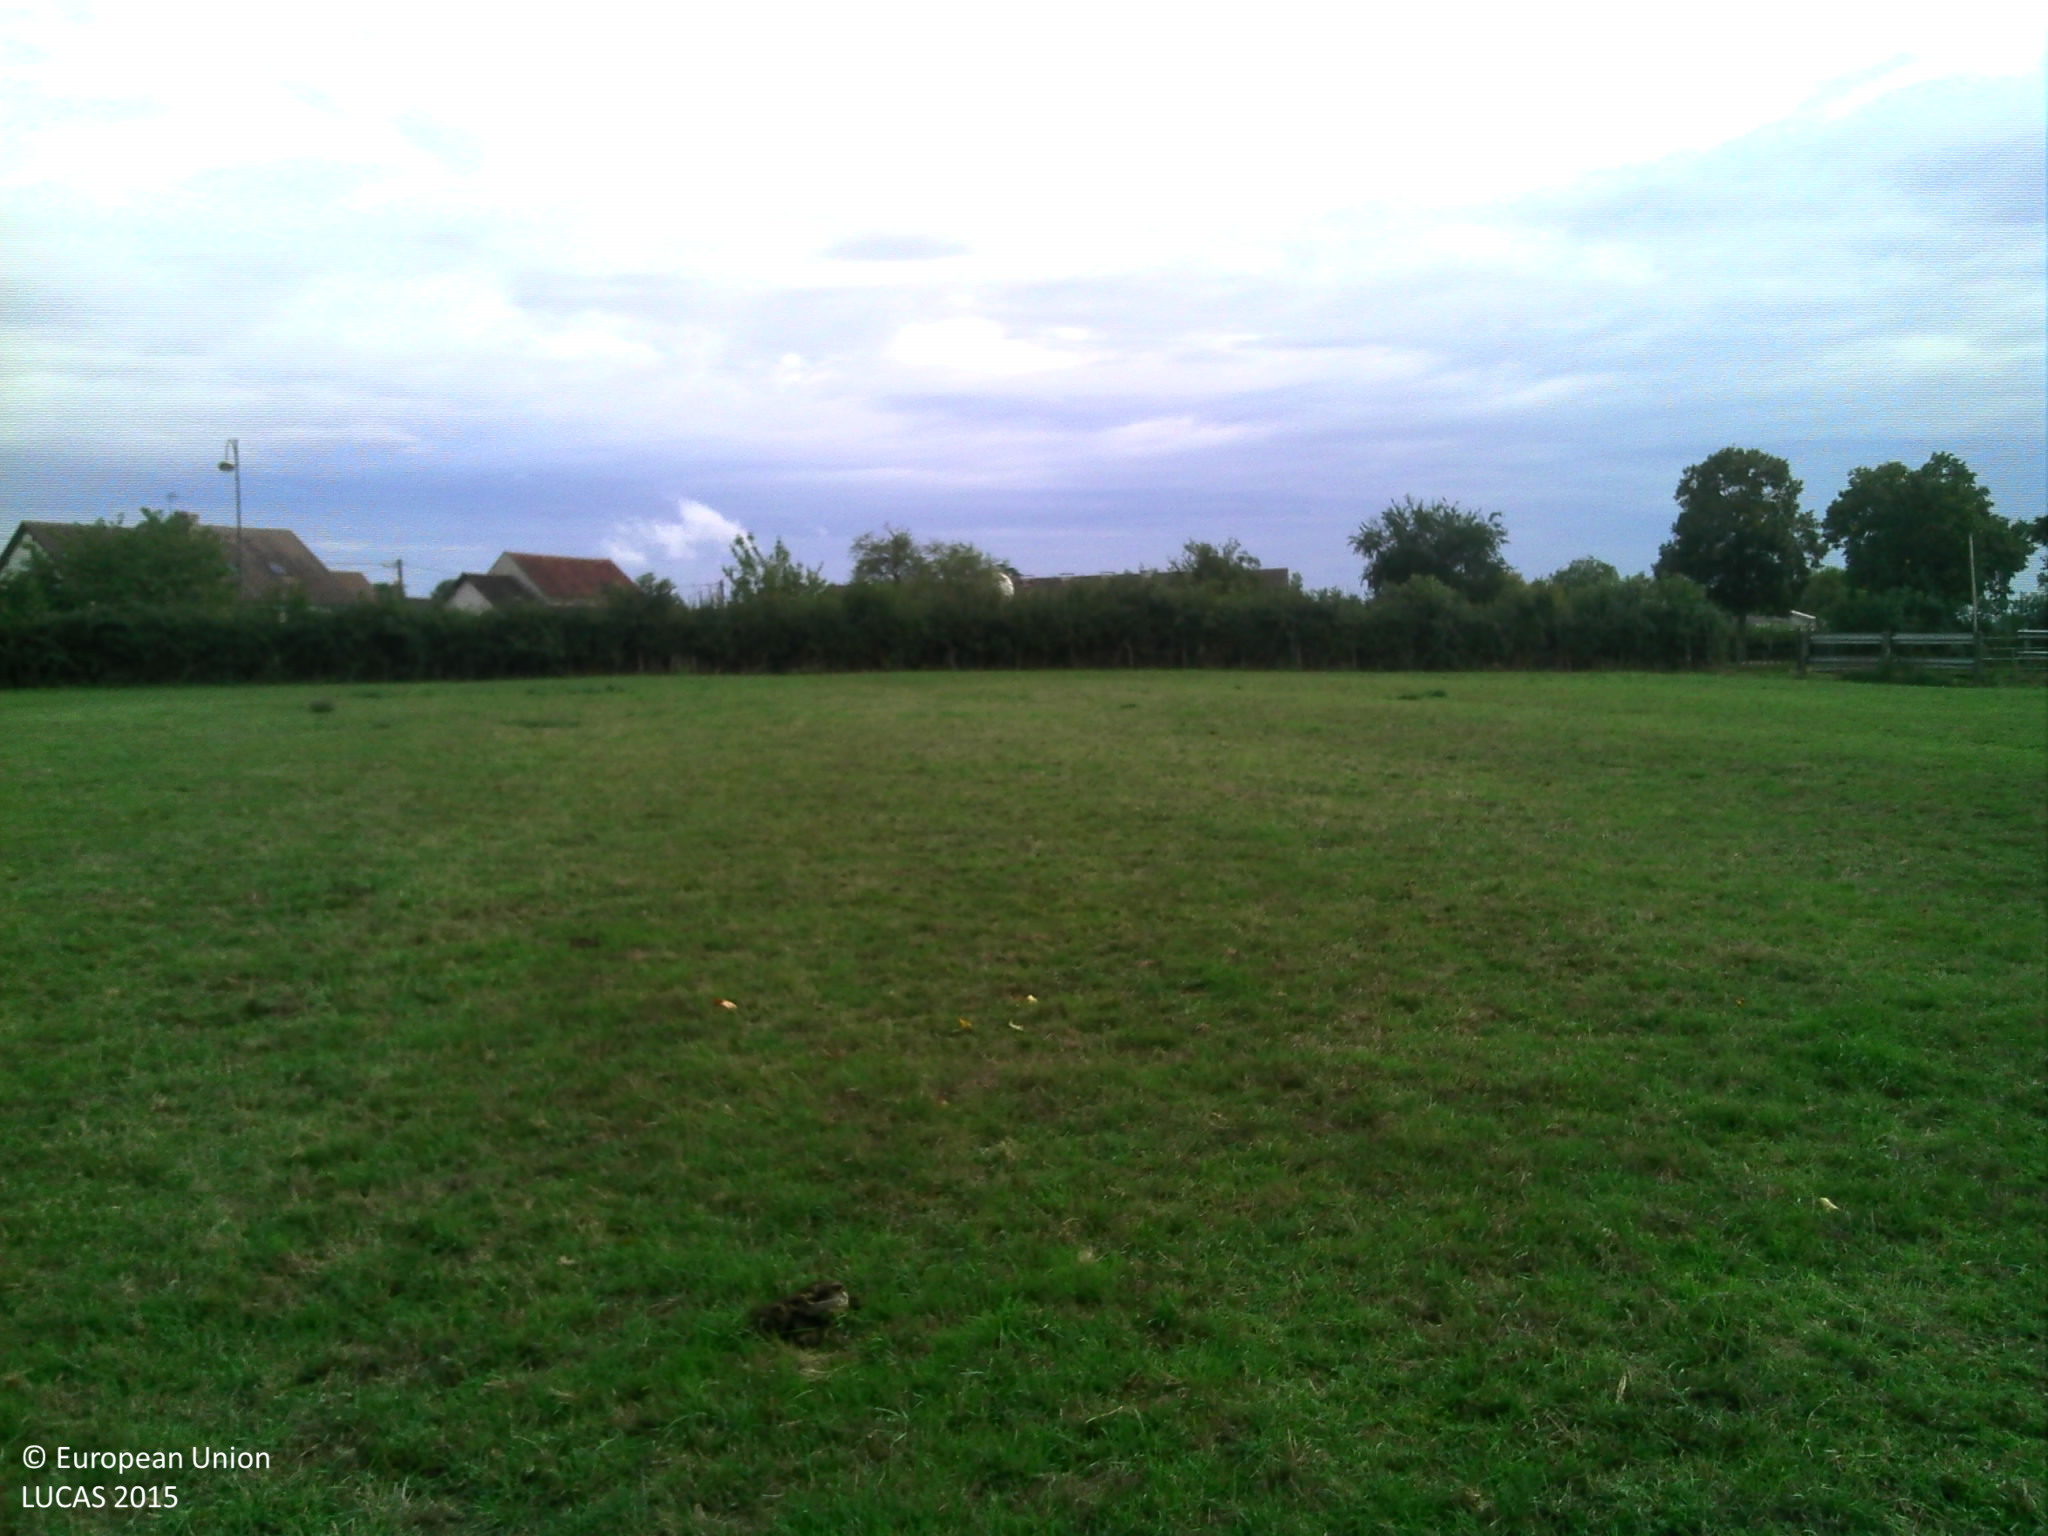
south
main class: Grassland
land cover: Grassland without tree/shrub cover
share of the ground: > 75 %
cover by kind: herbaceous plants 100 %
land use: Agriculture (excluding fallow land and kitchen gardens)
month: September
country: FR
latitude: 47.3913
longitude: 4.3155
